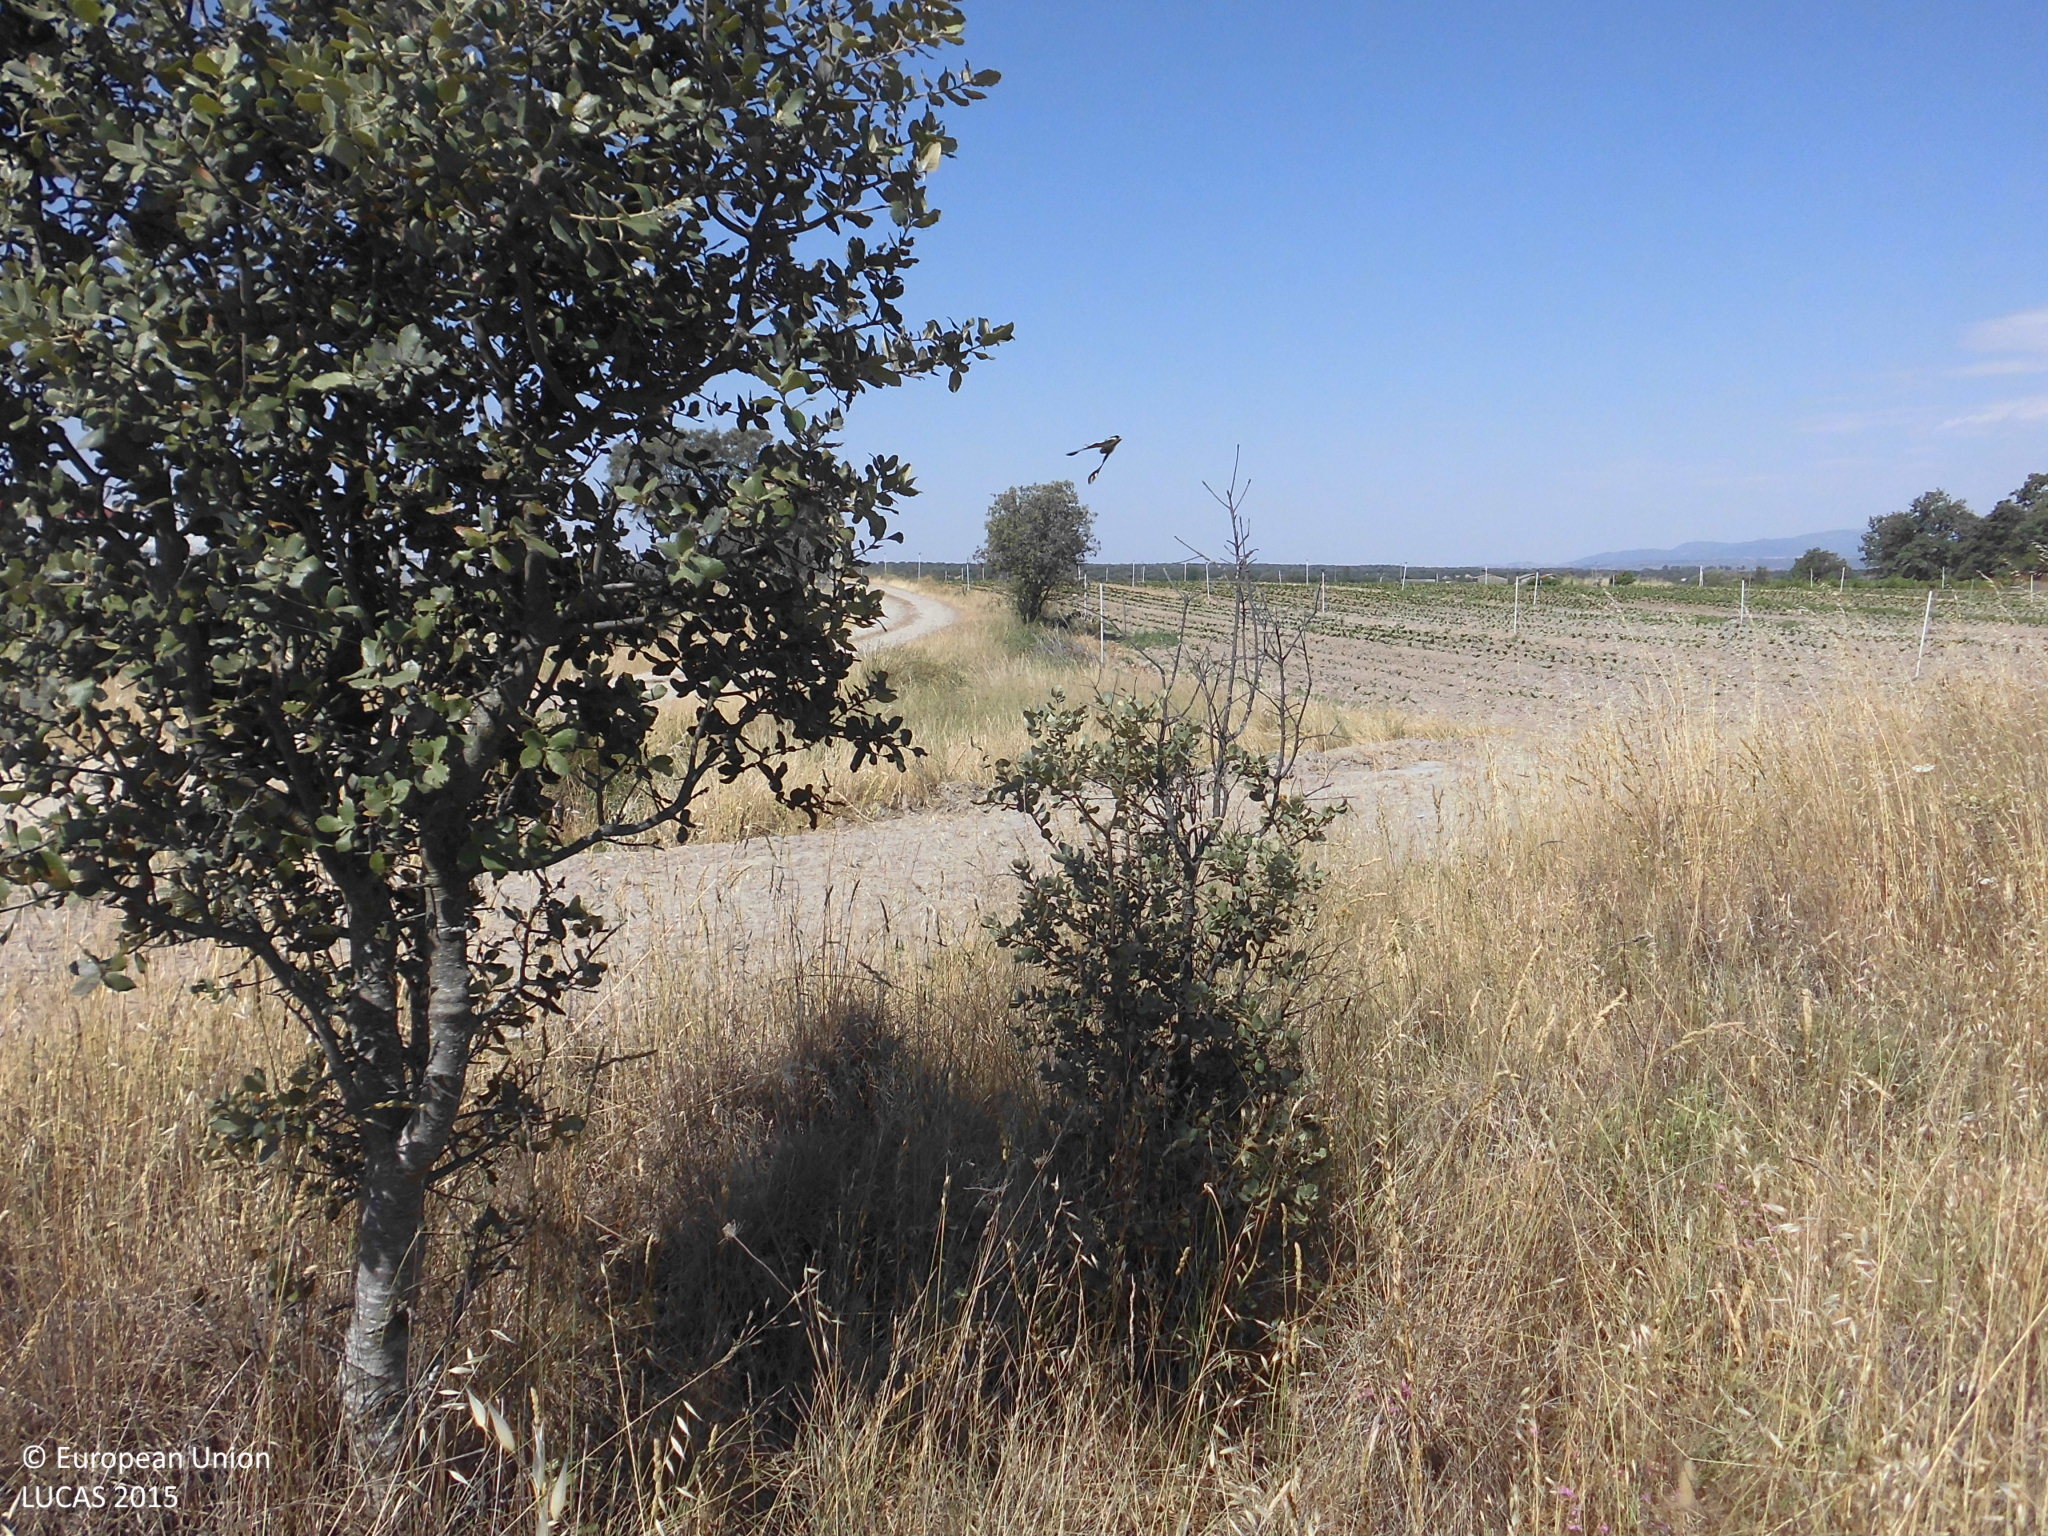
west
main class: Grassland
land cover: Grassland with sparse tree/shrub cover
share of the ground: 25 - 50 %
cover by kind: herbaceous plants 60 %, consolidated bare surface 30 %, broadleaved forest trees 5 %, shrubs 5 %
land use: Abandoned areas
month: June
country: ES
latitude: 40.0249
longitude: -5.4681
